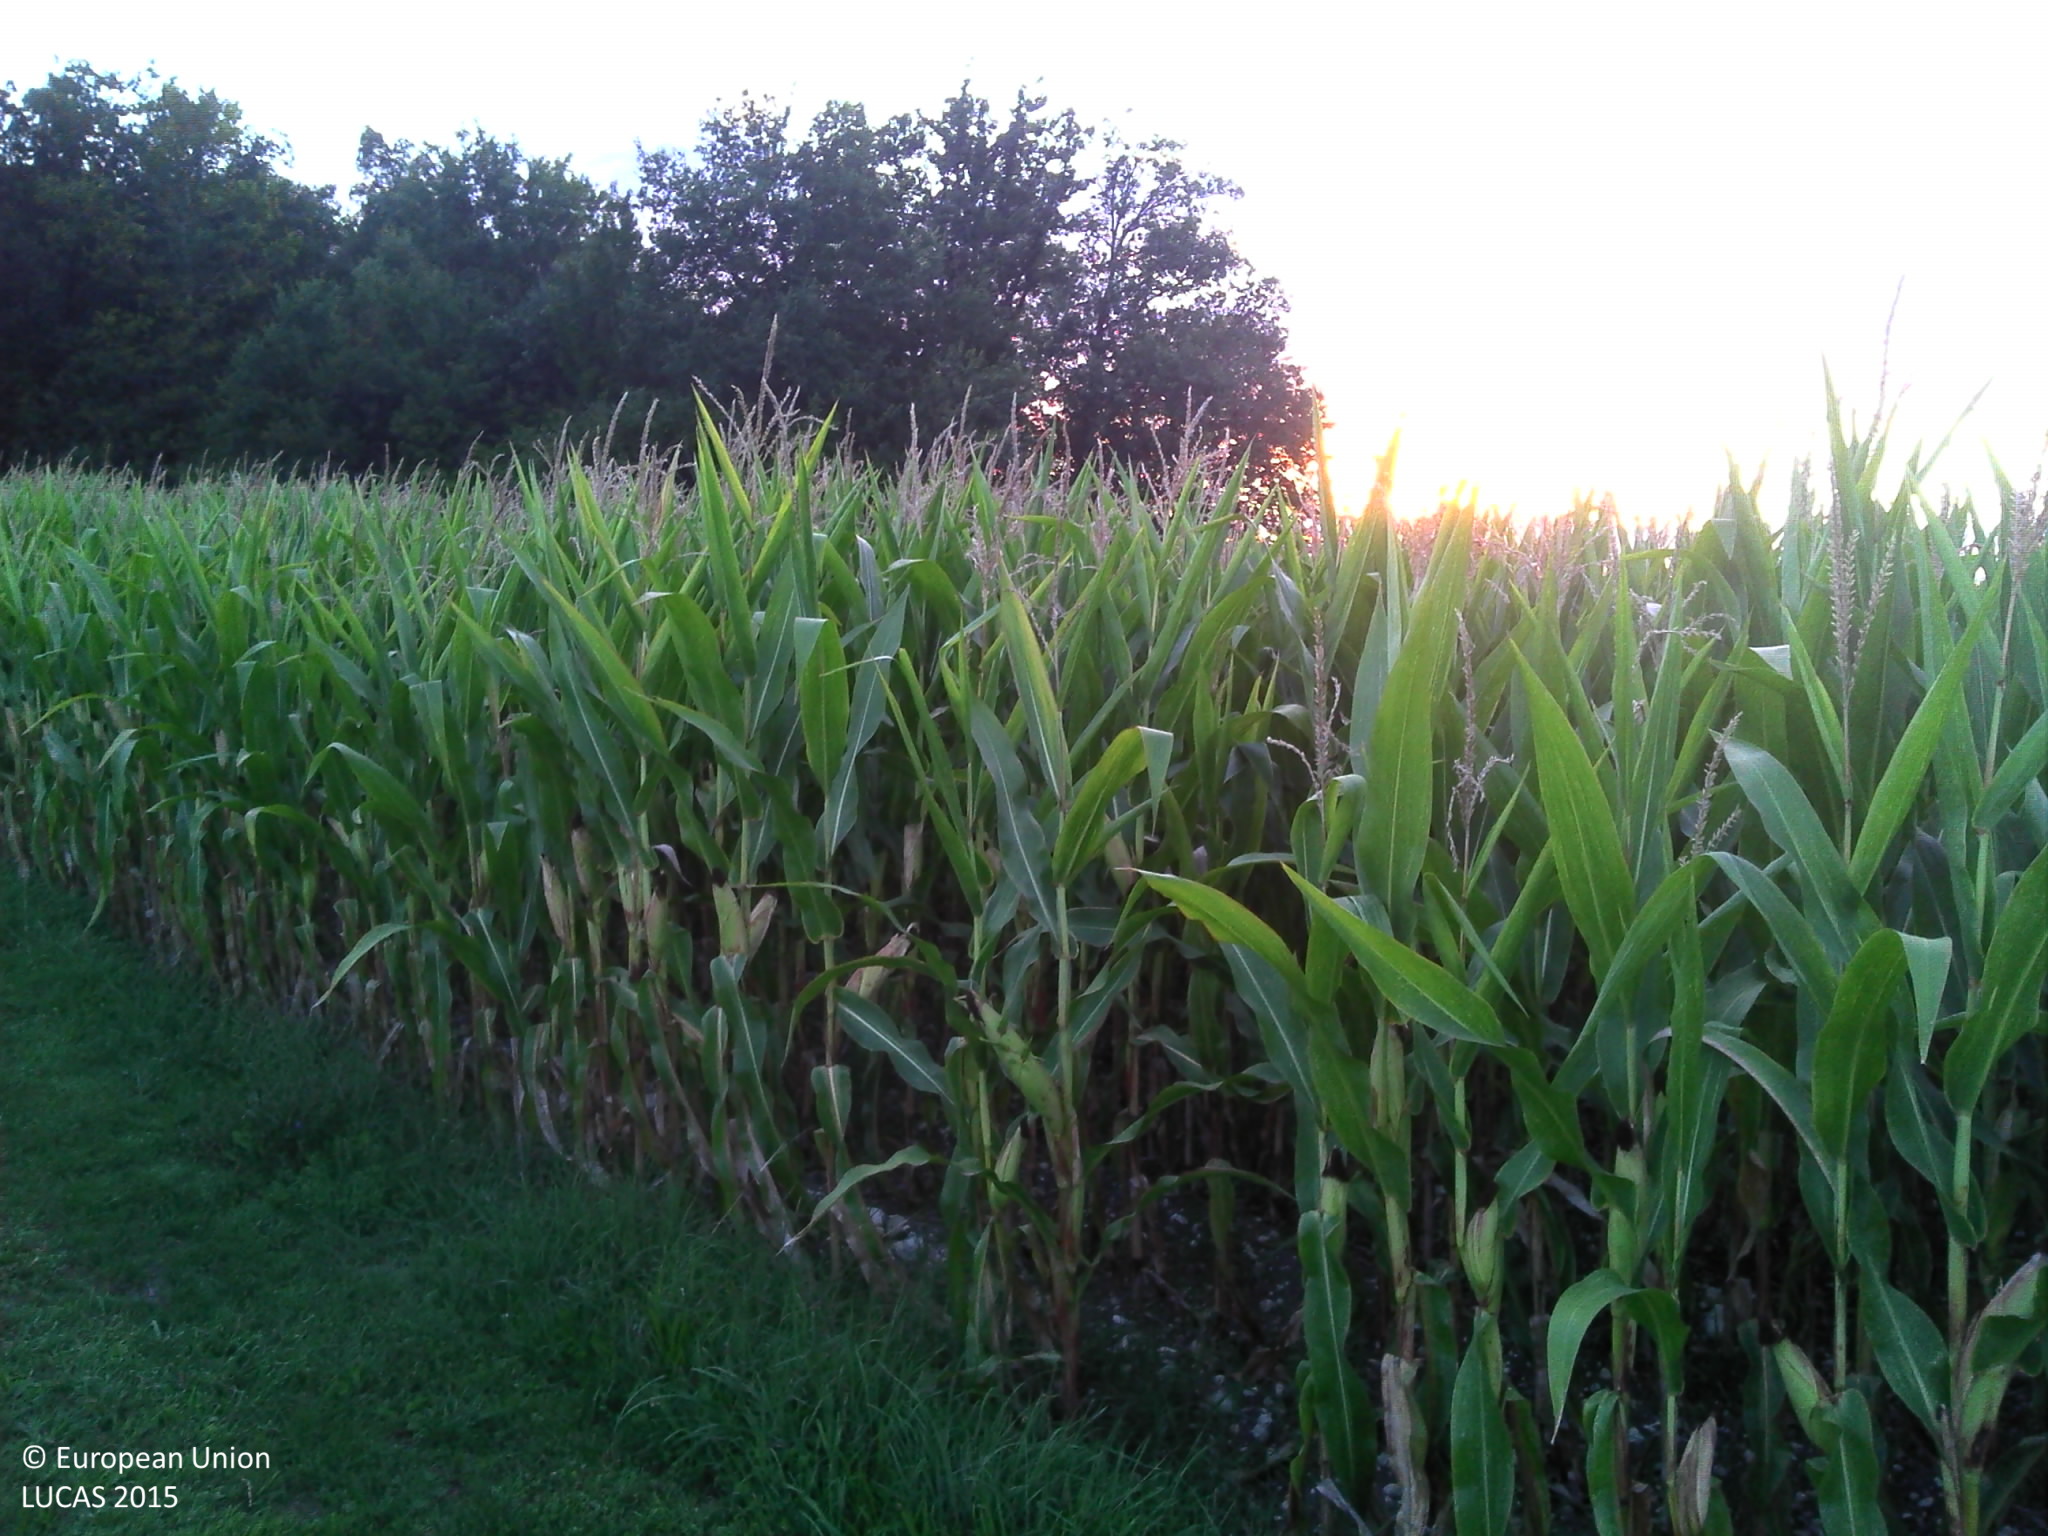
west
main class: Cropland
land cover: Sunflower
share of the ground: > 75 %
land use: Agriculture (excluding fallow land and kitchen gardens)
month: August
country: FR
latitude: 45.2336
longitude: 0.4474
